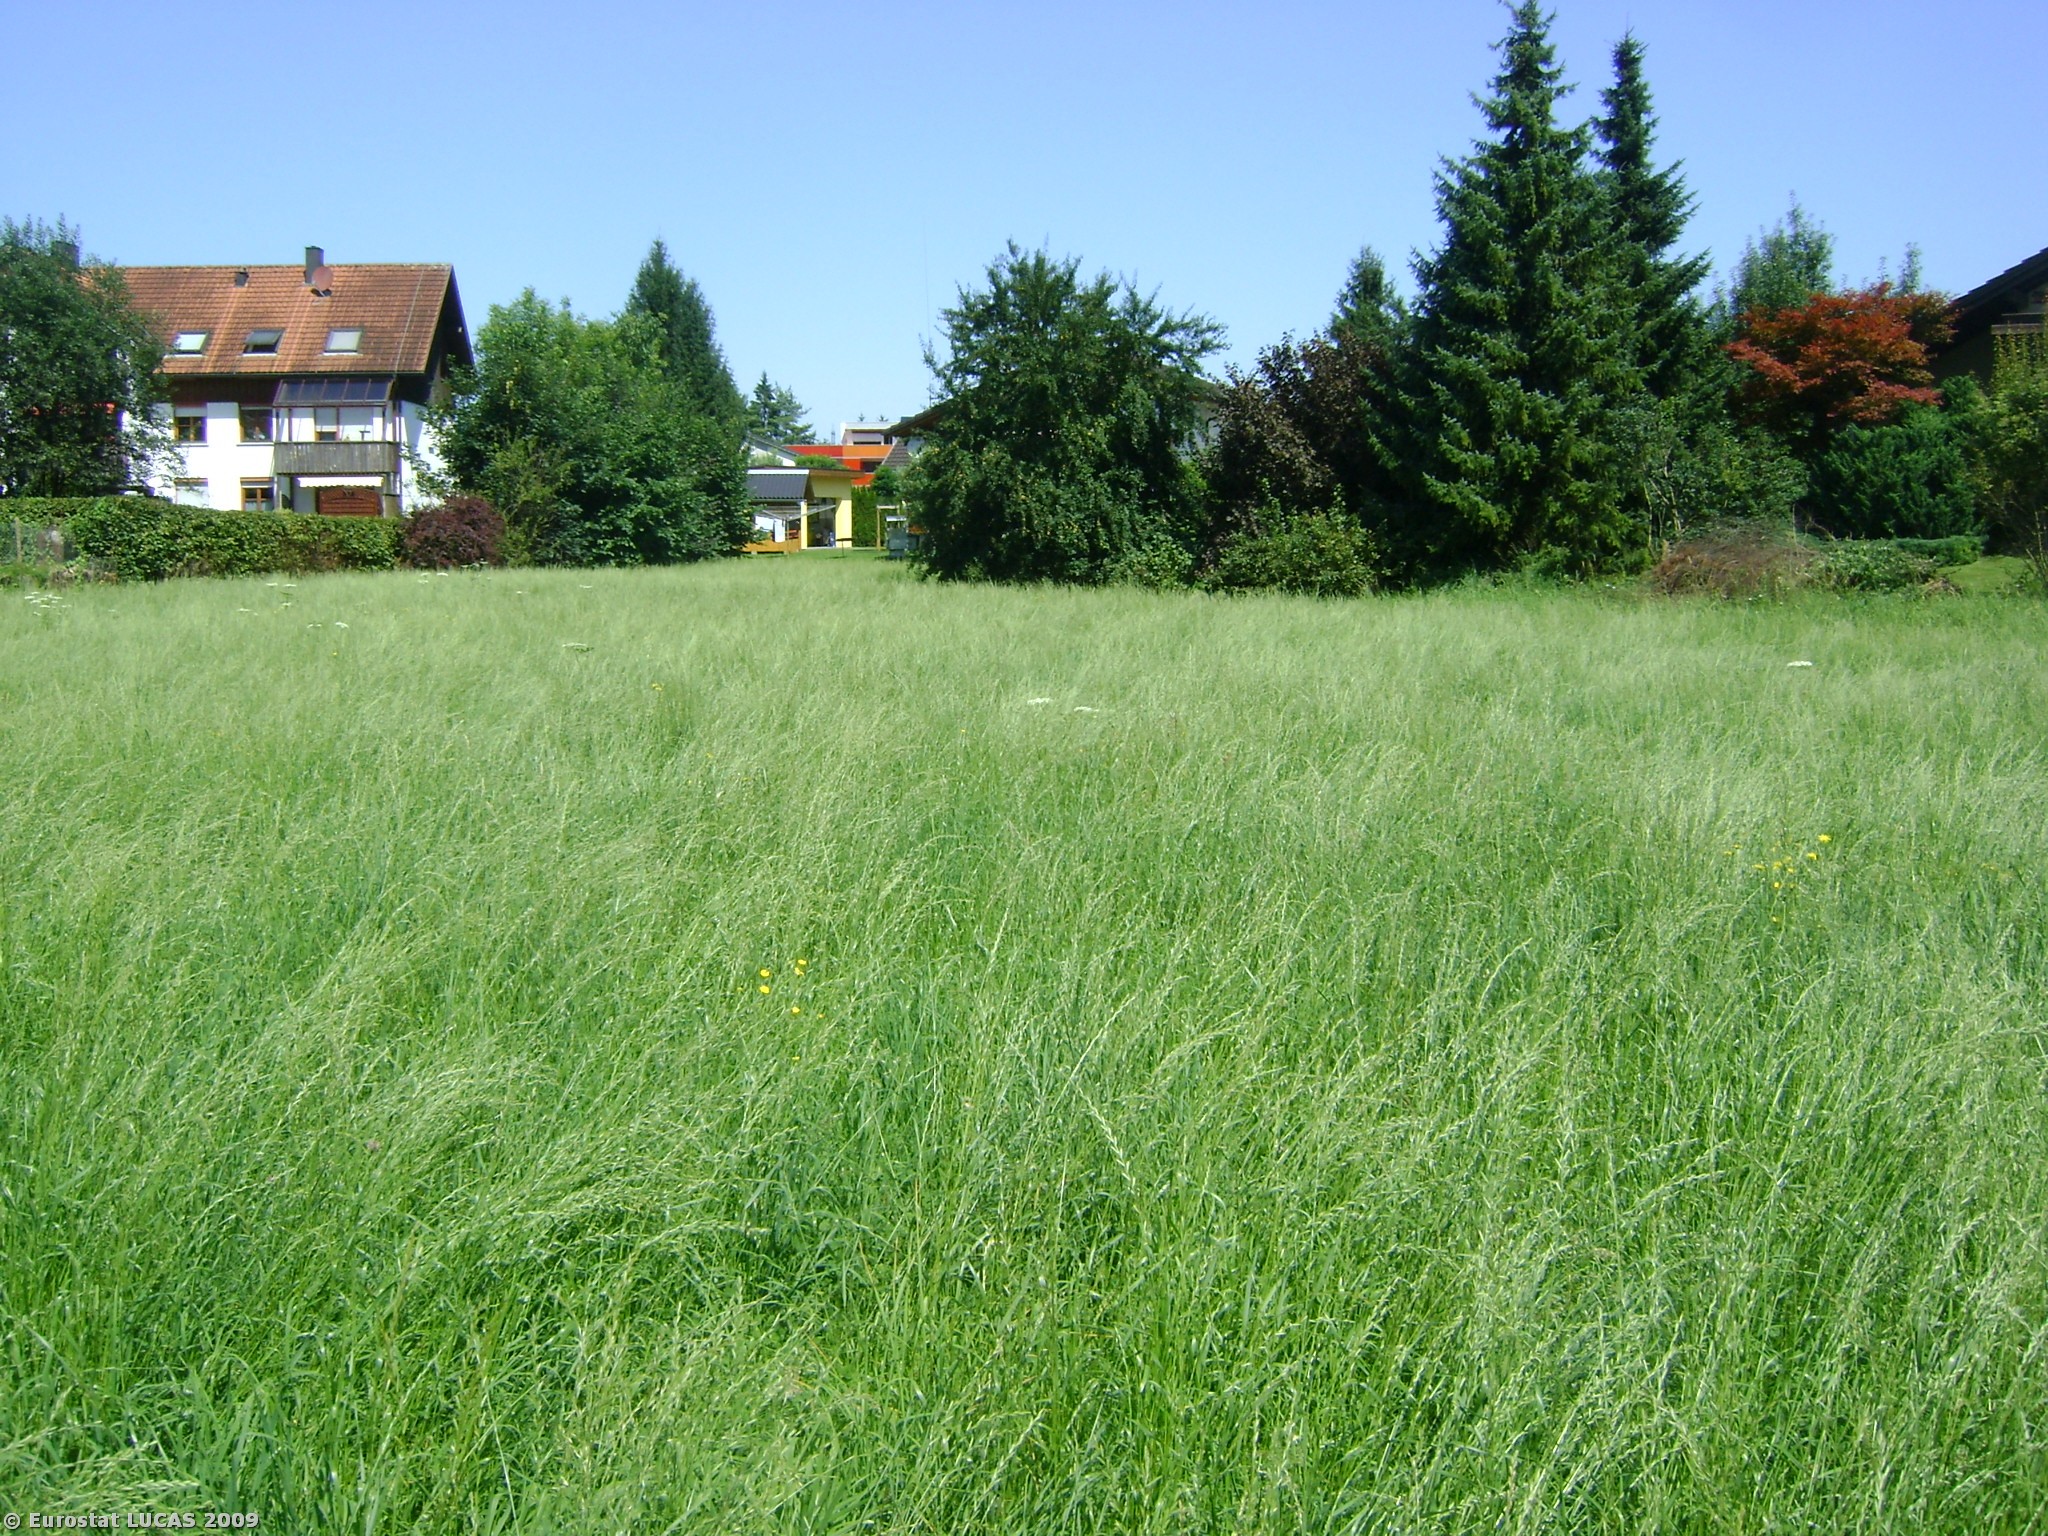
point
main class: Grassland
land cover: Grassland without tree/shrub cover
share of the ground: > 75 %
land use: Agriculture (excluding fallow land and kitchen gardens)
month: July
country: AT
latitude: 47.3591
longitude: 9.6693
